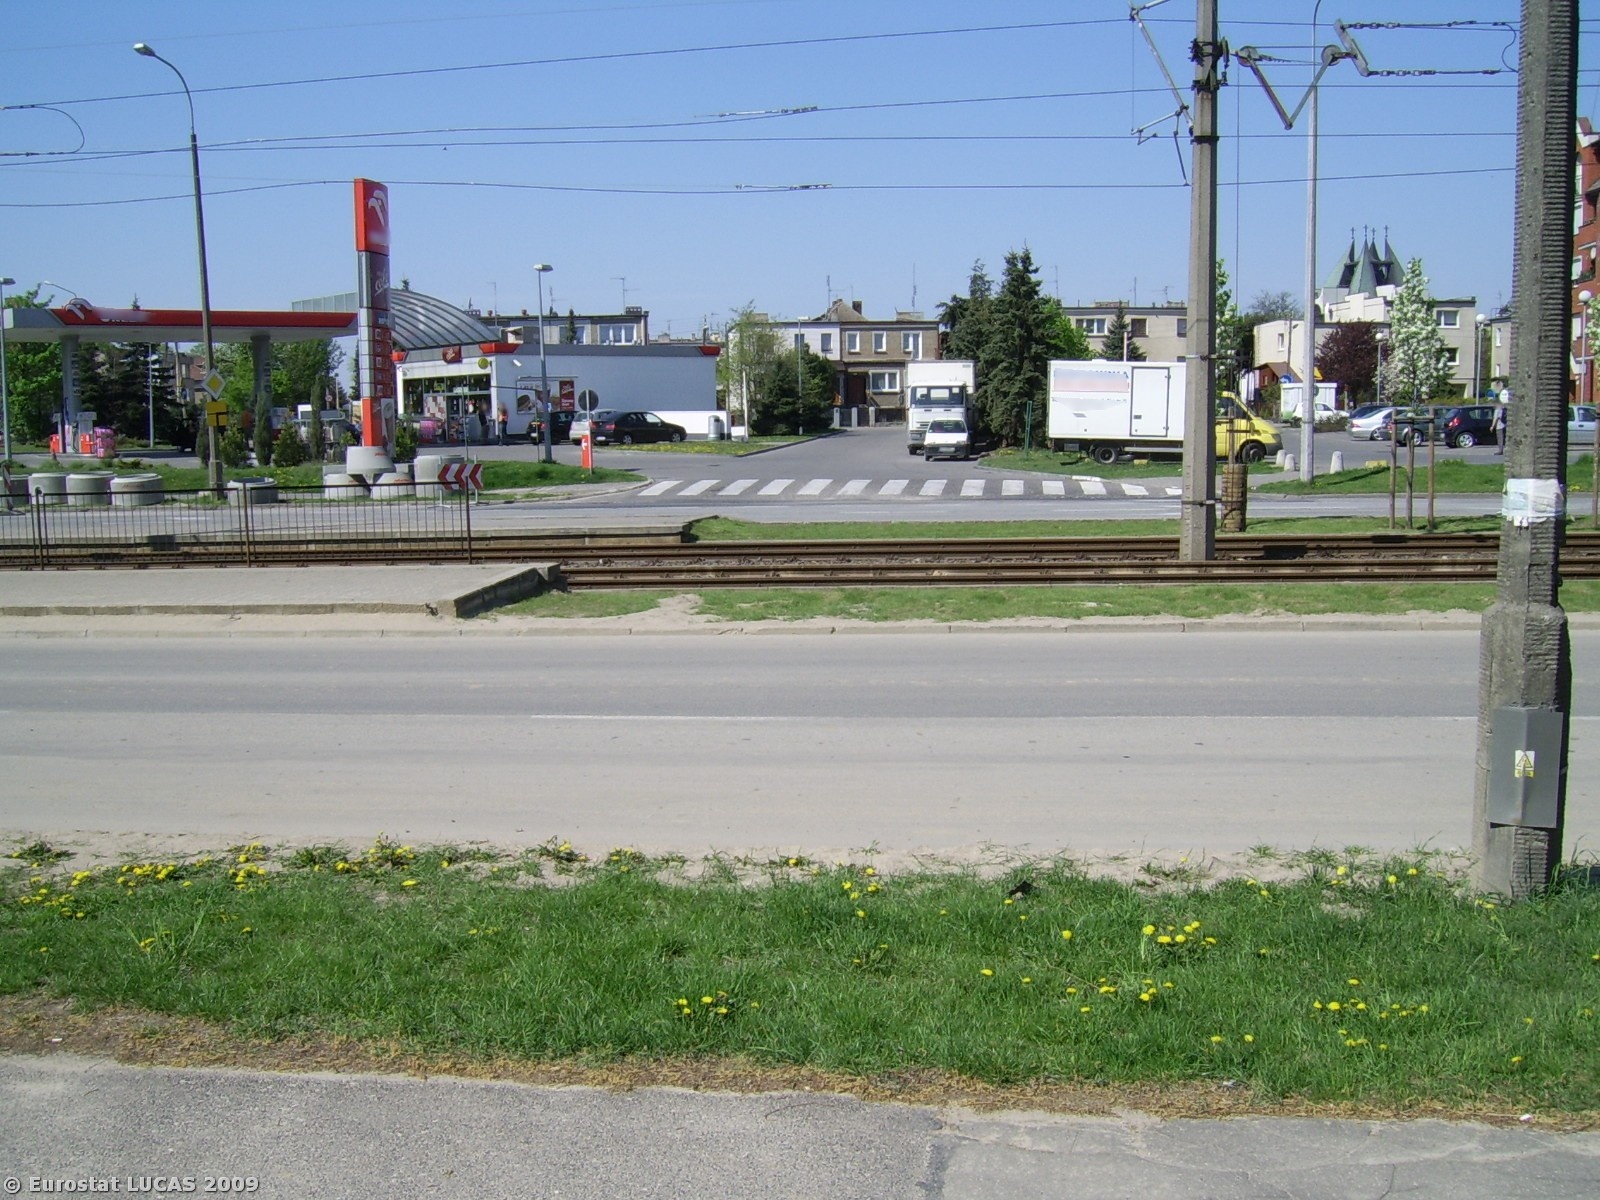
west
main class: Woodland
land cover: Broadleaved woodland
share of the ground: > 75 %
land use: Commerce, finance, business
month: April
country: PL
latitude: 52.4272
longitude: 16.9362
